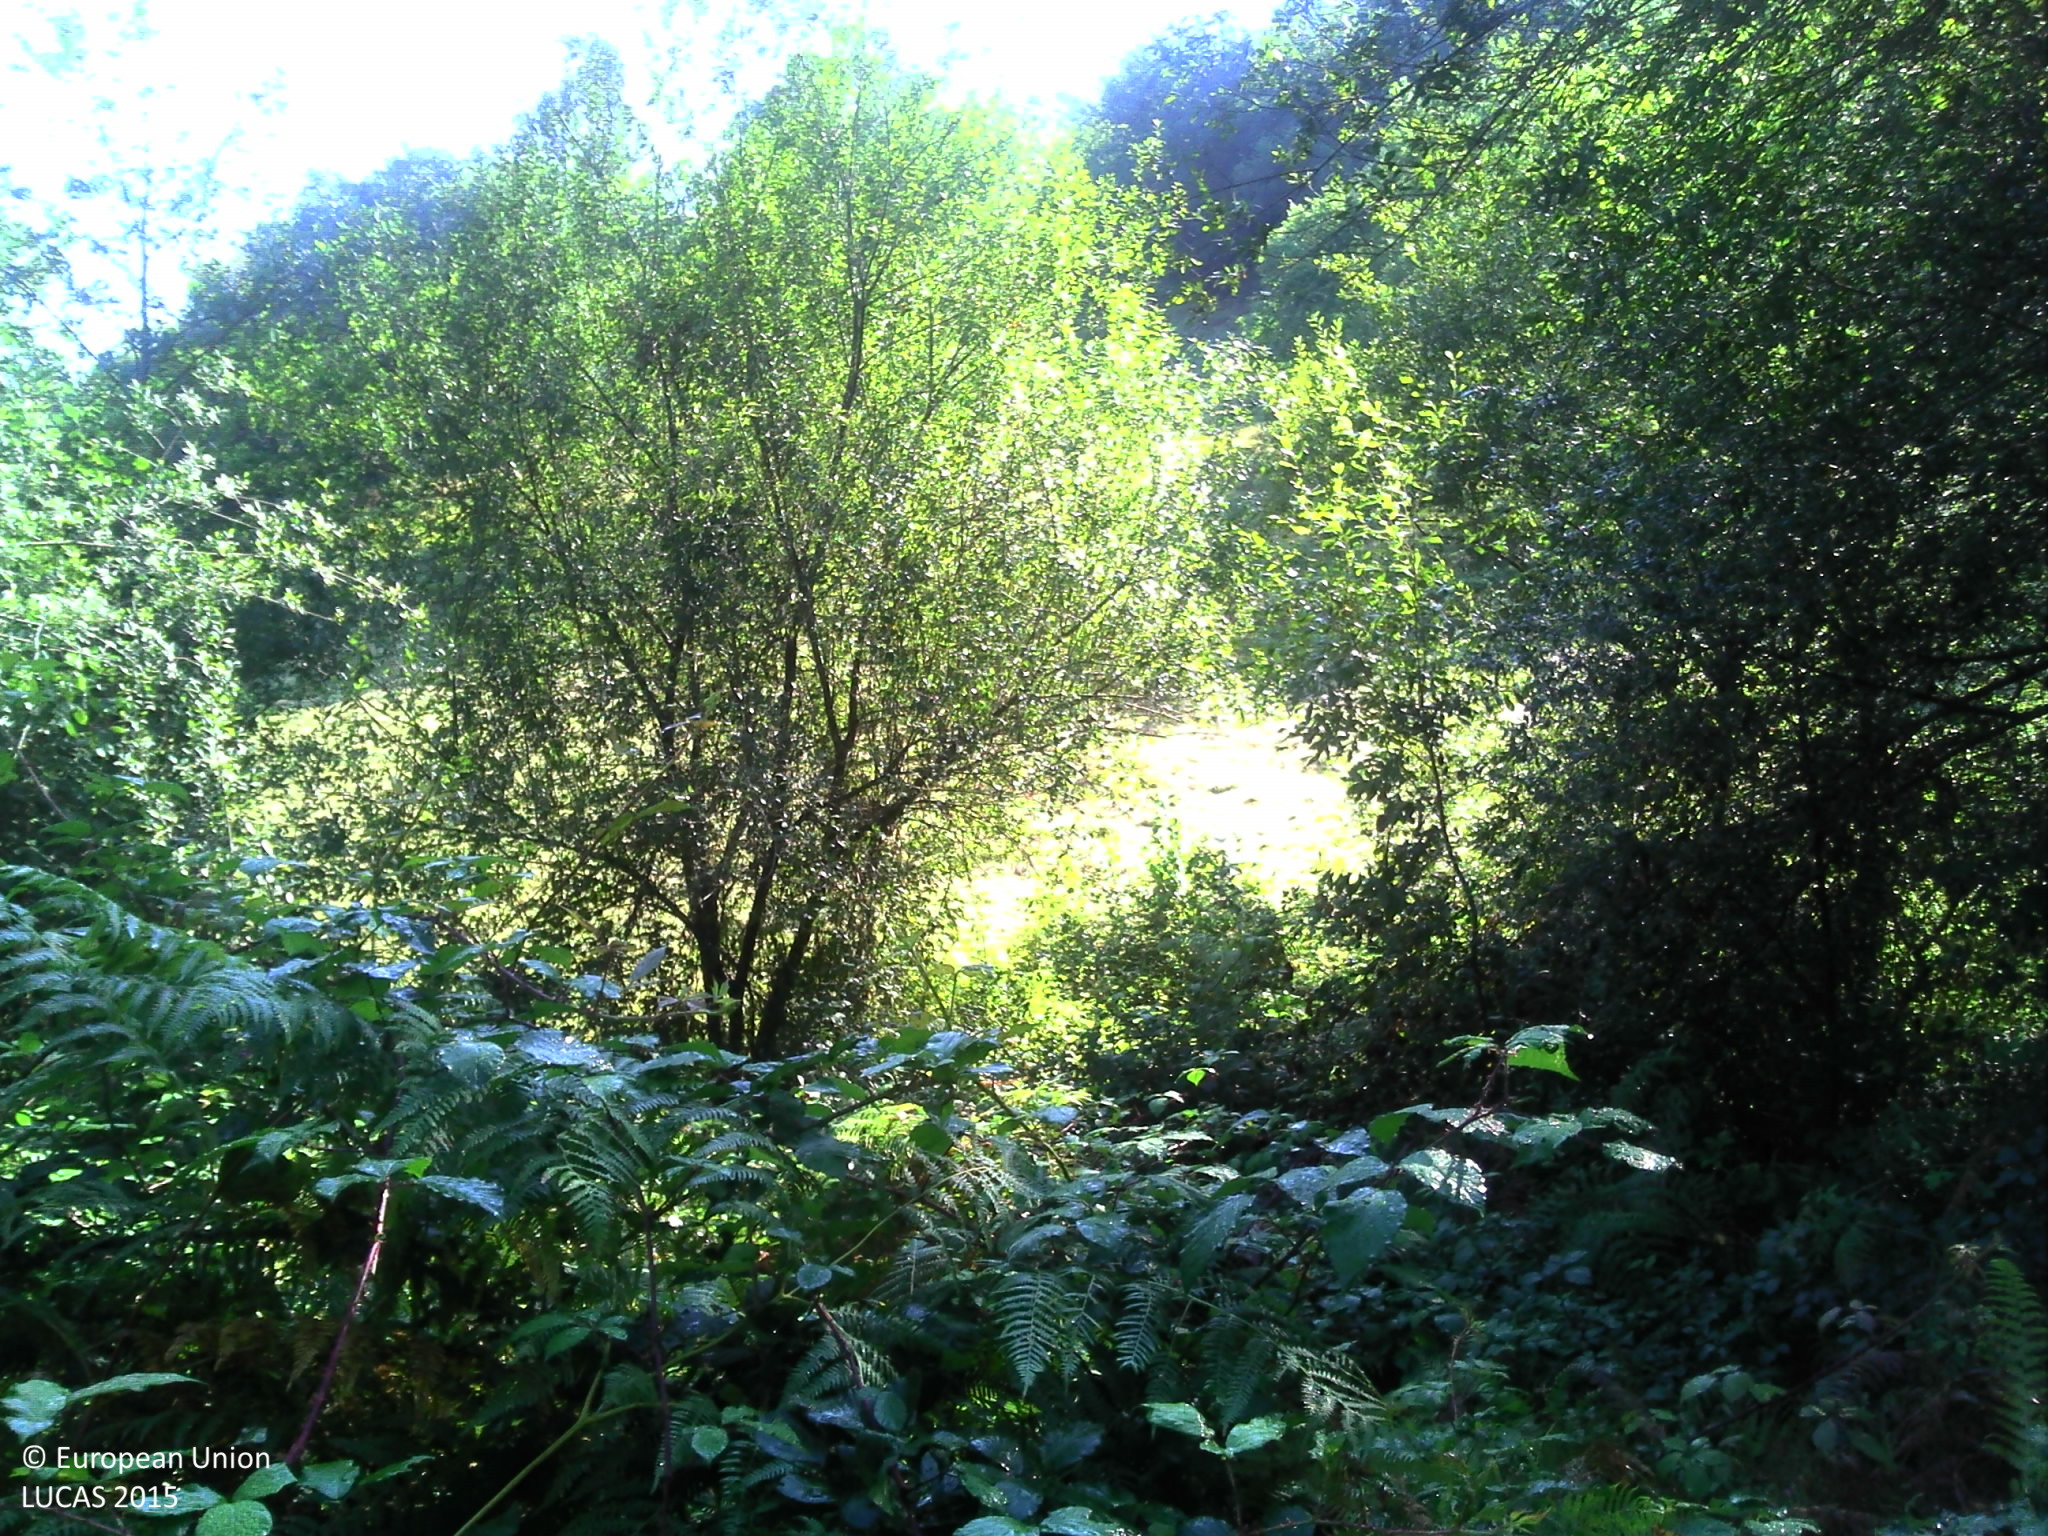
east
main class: Shrubland
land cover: Shrubland with sparse tree cover
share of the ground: > 75 %
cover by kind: shrubs 55 %, herbaceous plants 40 %, broadleaved forest trees 5 %
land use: Semi-natural and natural areas not in use
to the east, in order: Shrubland with sparse tree cover; Broadleaved woodland; Ditches and canals; Grassland without tree/shrub cover; Single bushes/trees; Tracks; Single bushes/trees; Grassland without tree/shrub cover; Broadleaved woodland; Tracks; Broadleaved woodland
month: September
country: FR
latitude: 43.1033
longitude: -0.8839
